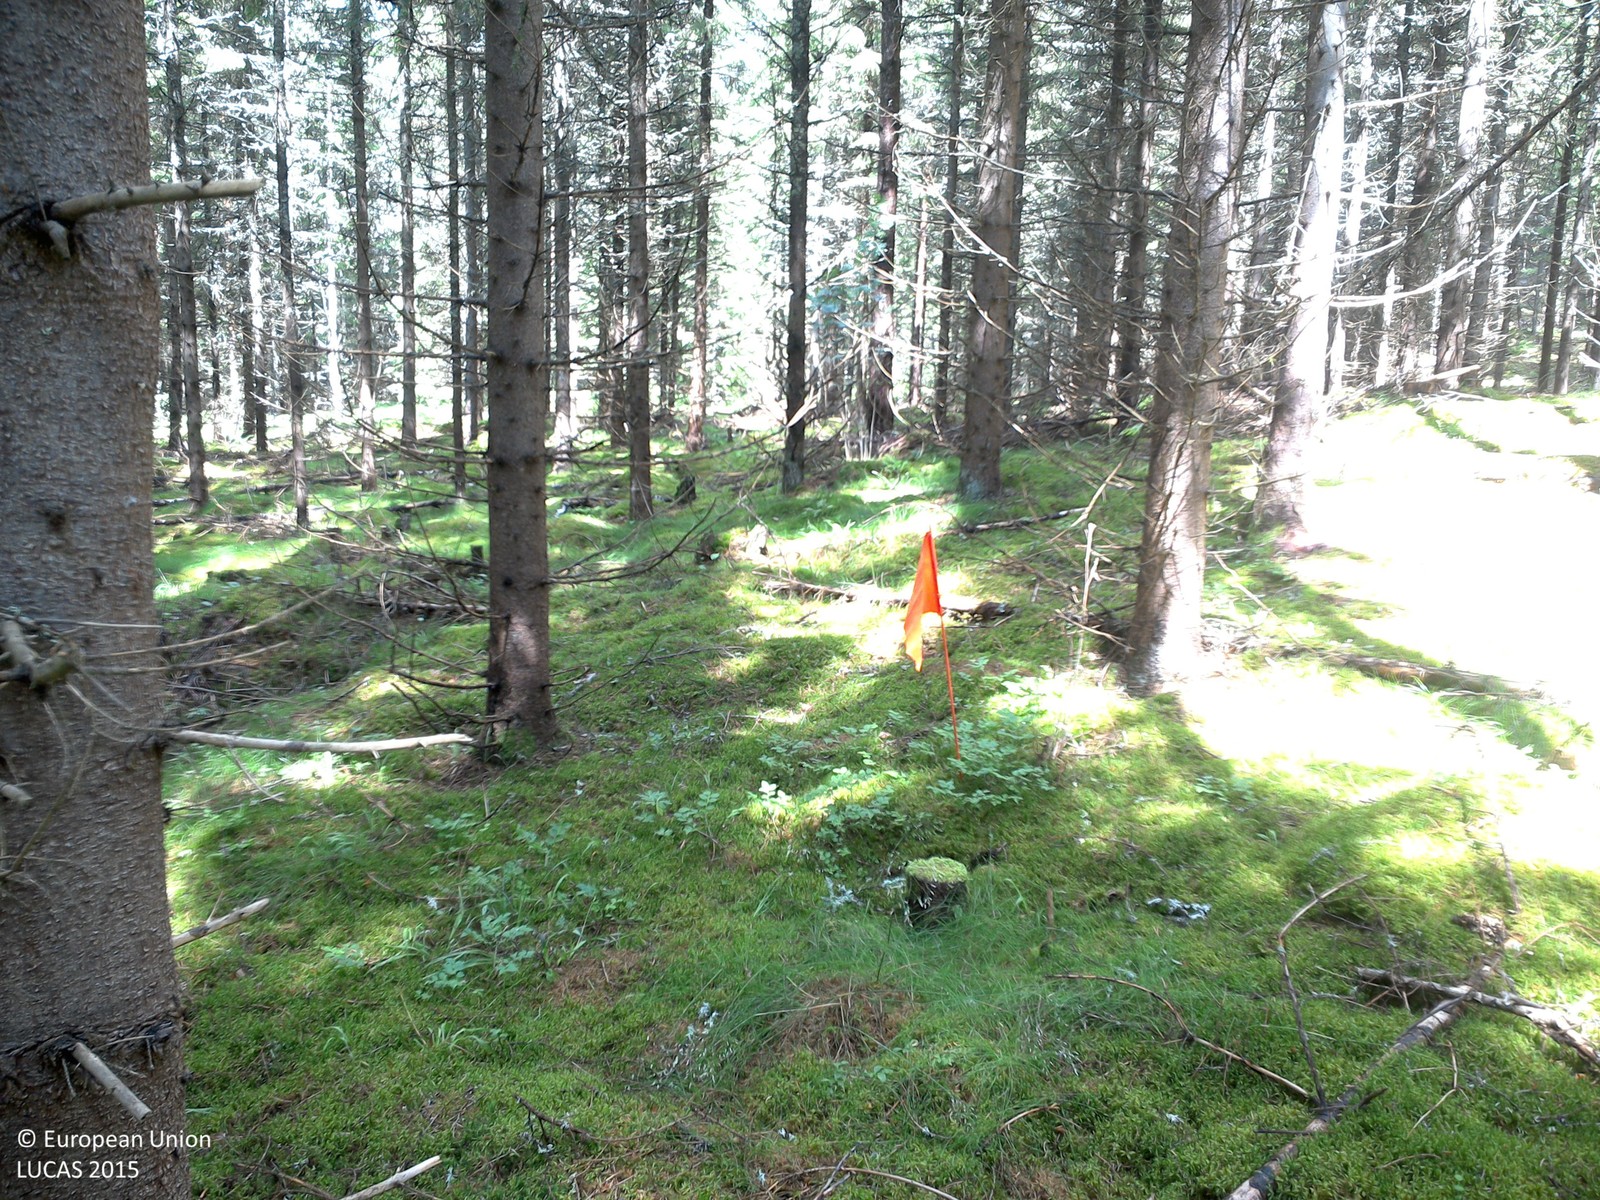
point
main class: Woodland
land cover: Spruce dominated coniferous woodland
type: boreal forest
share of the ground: > 75 %
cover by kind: coniferous forest trees 75 %, lichens and mosses 25 %
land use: Forestry
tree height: > 5 m
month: July
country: SE
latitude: 58.5965
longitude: 14.9661
